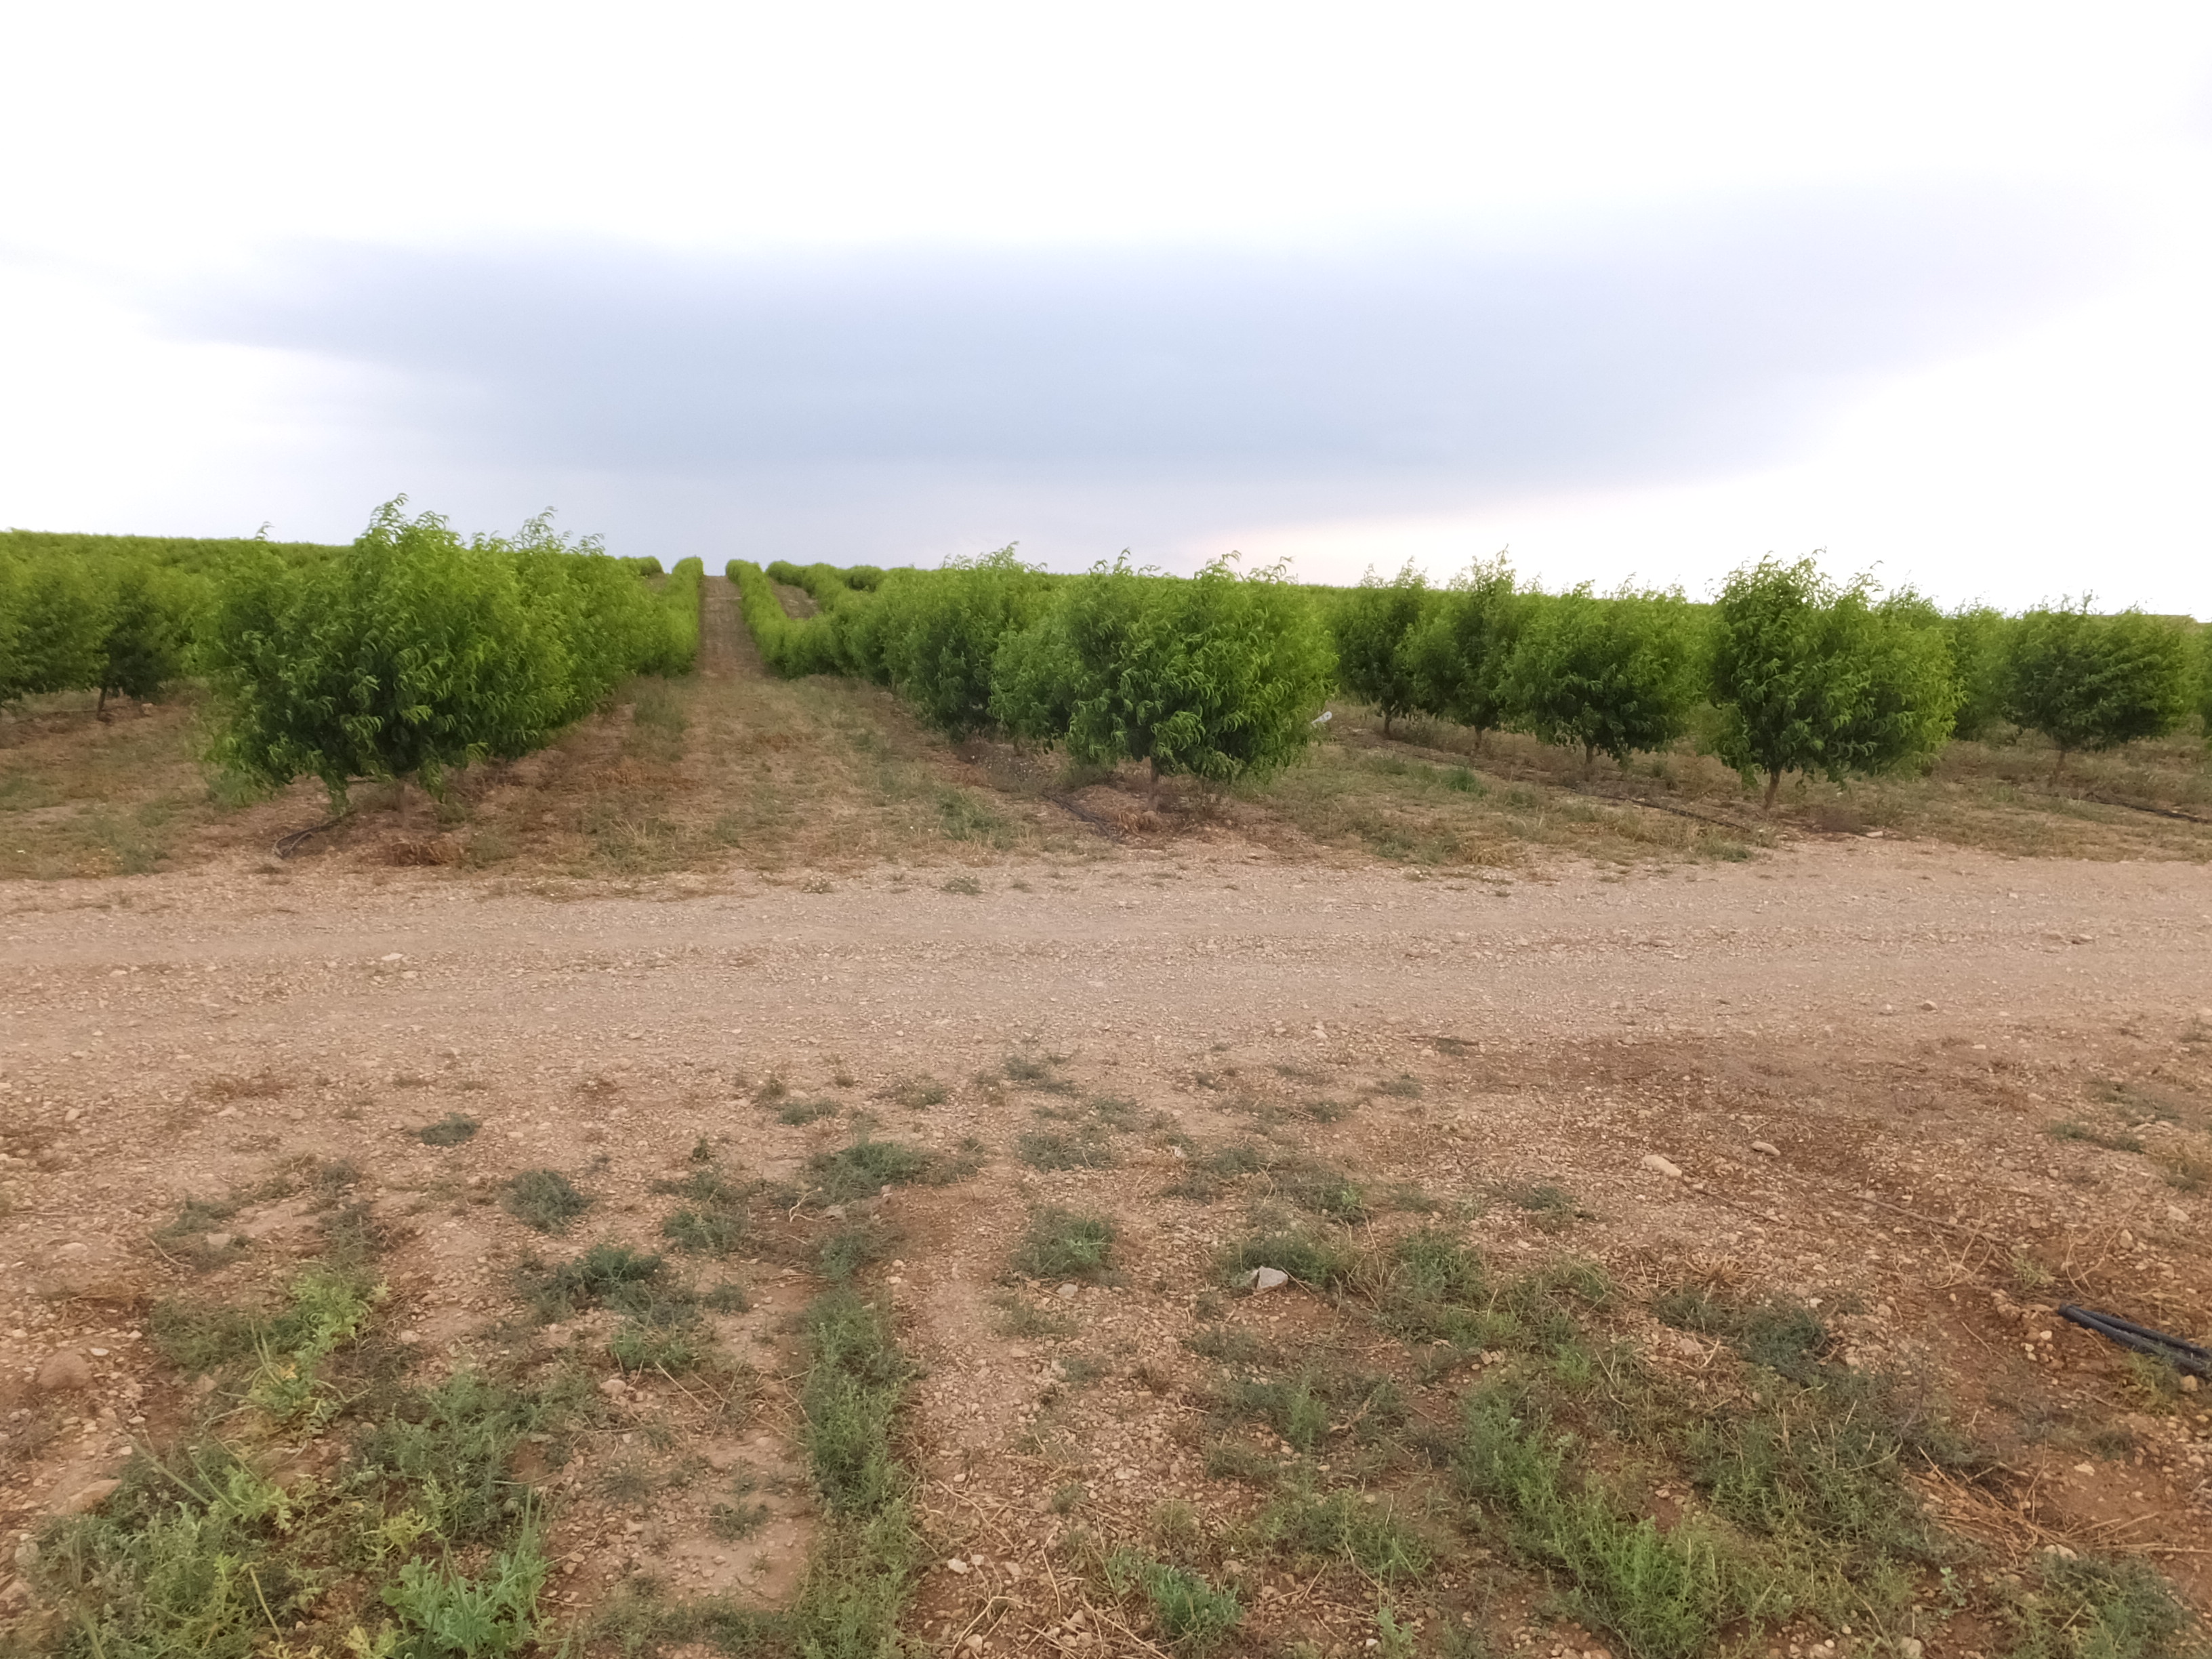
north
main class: Cropland
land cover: Other fruit trees and berries
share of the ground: < 10 %
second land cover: Spontaneously vegetated surfaces
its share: 50 - 75 %
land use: Agriculture (excluding fallow land and kitchen gardens)
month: June
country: ES
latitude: 41.6338
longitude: 0.0330
